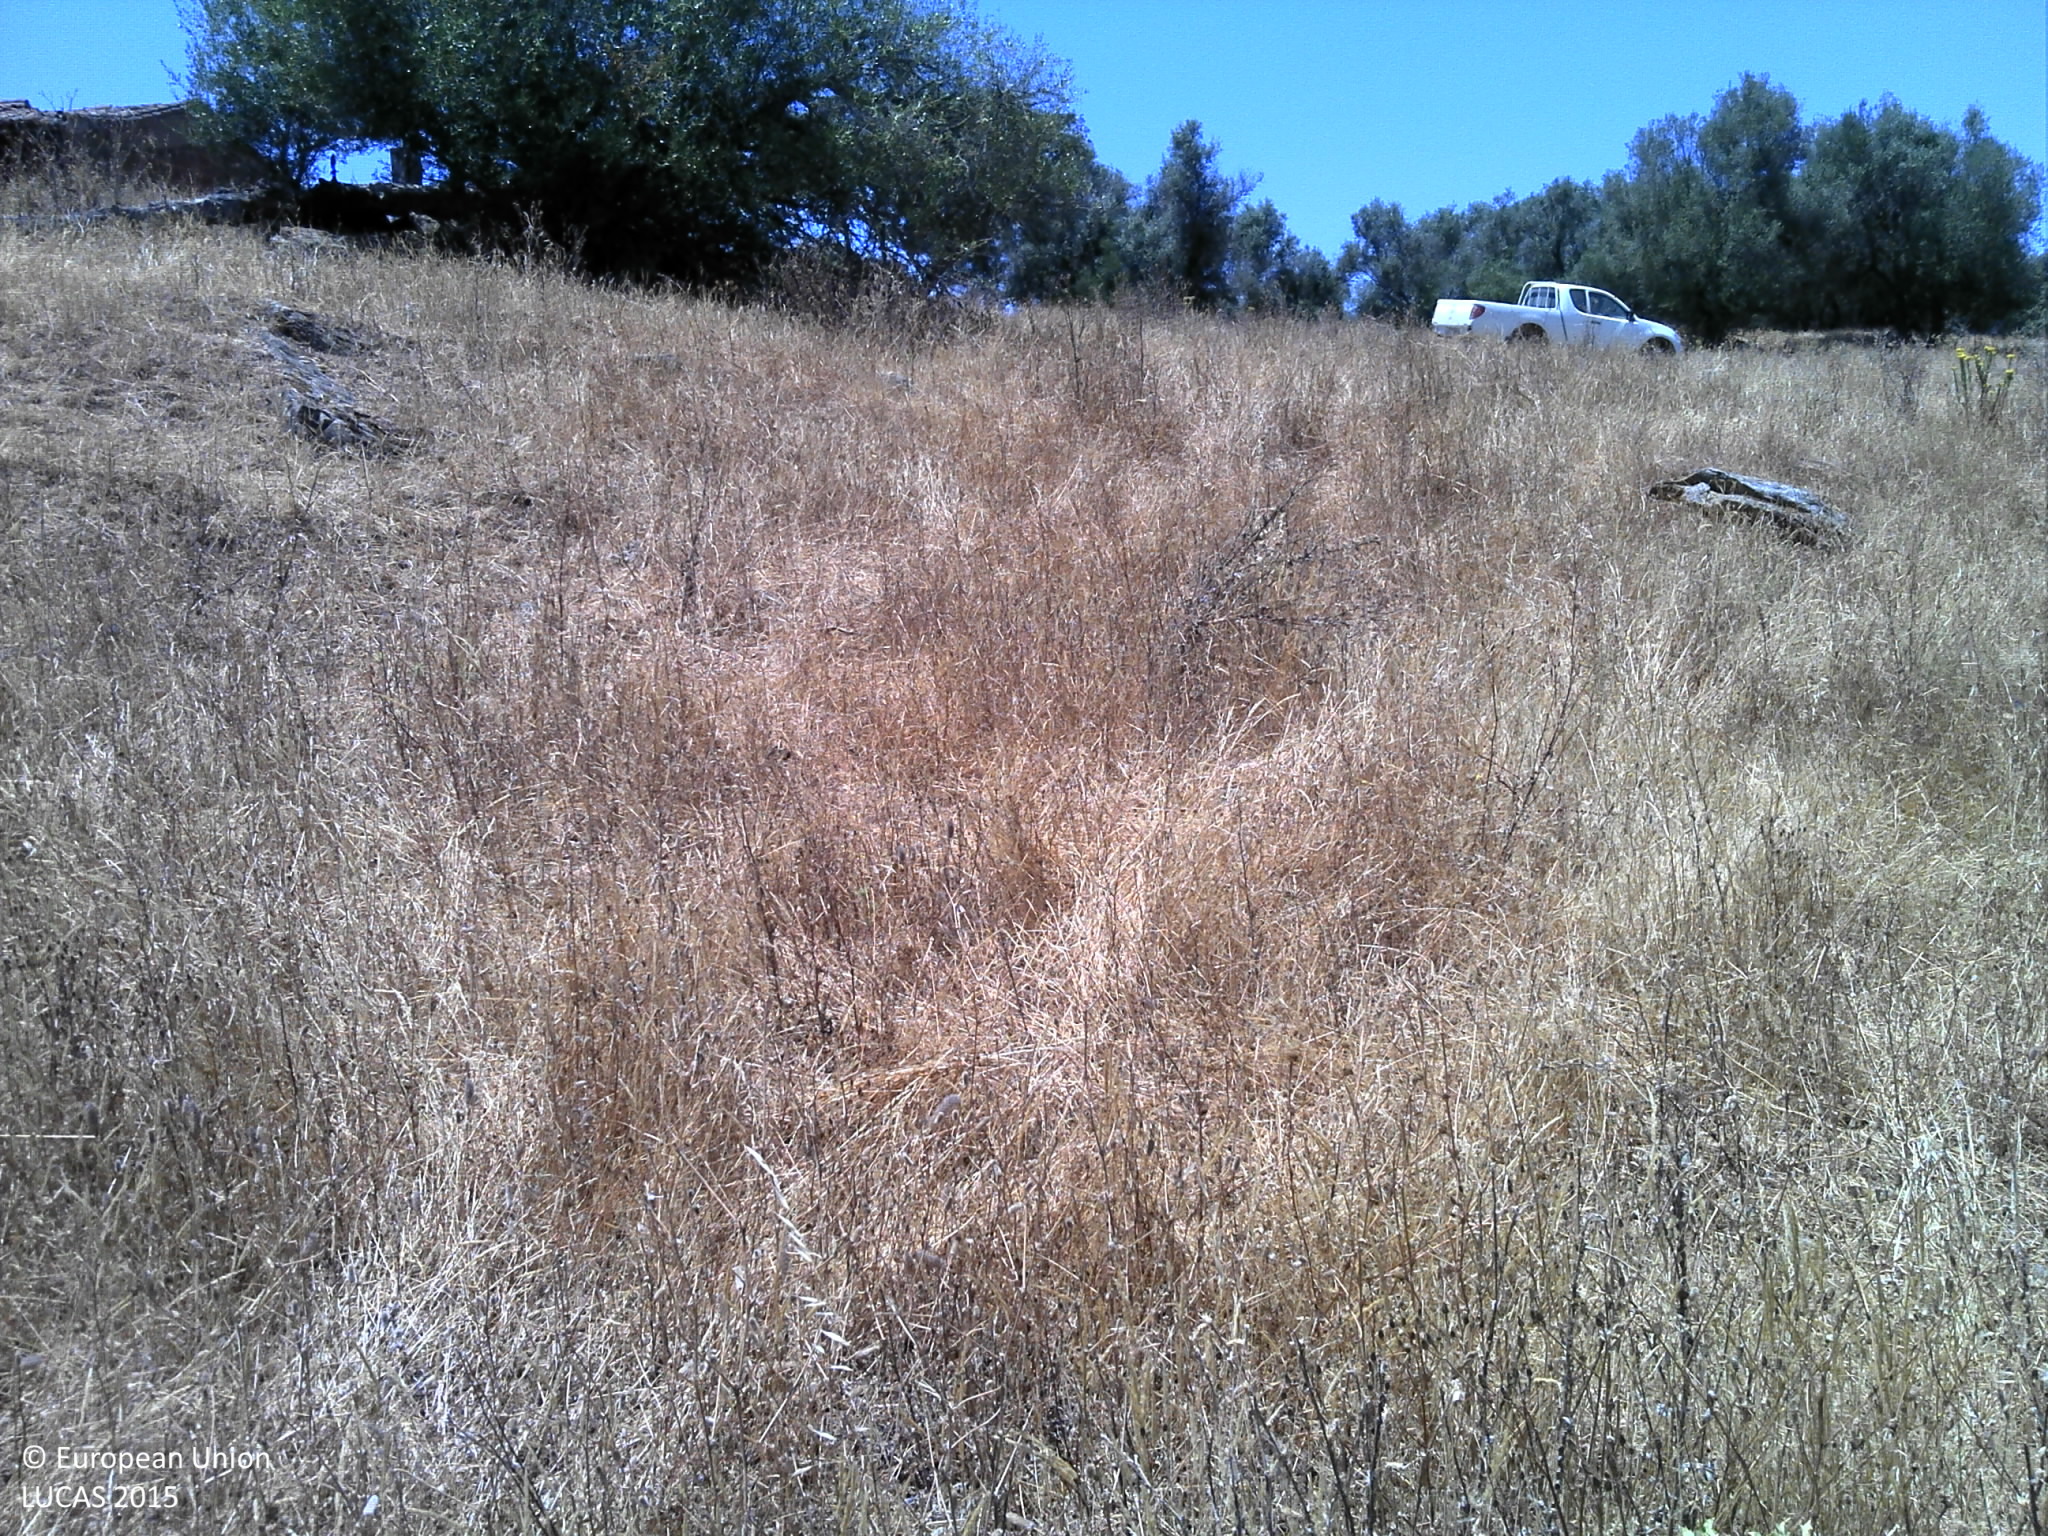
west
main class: Grassland
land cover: Grassland with sparse tree/shrub cover
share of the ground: 50 - 75 %
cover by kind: herbaceous plants 50 %, consolidated bare surface 45 %, broadleaved forest trees 5 %
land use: Agriculture (excluding fallow land and kitchen gardens)
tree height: > 5 m
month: July
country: PT
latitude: 37.7180
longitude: -8.2852
